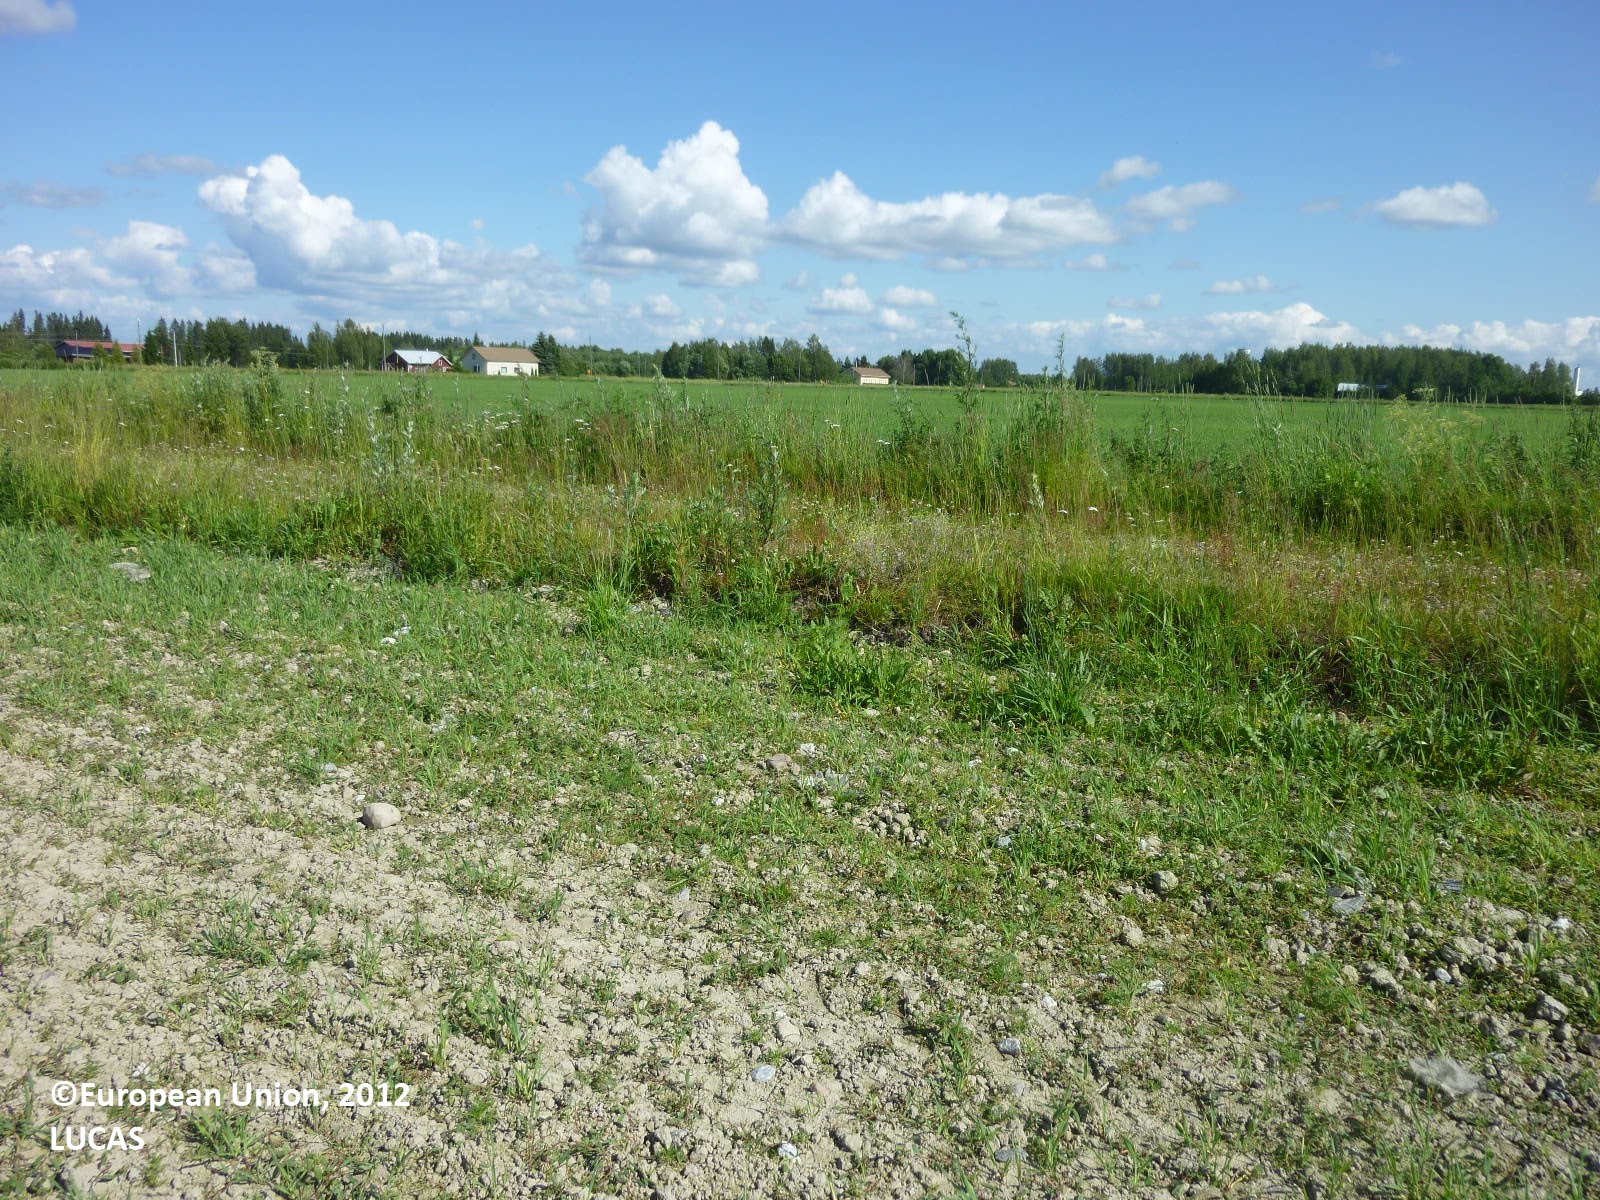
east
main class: Grassland
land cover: Spontaneously vegetated surfaces
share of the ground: 10 - 25 %
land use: Fallow land
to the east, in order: Spontaneously vegetated surfaces; Temporary grasslands; Grass margins; Paved roads, cycling and walking lanes; Barley; Grassland without tree/shrub cover; Ditches and canals; Grassland without tree/shrub cover
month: July
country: FI
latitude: 61.3833
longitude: 21.9796
